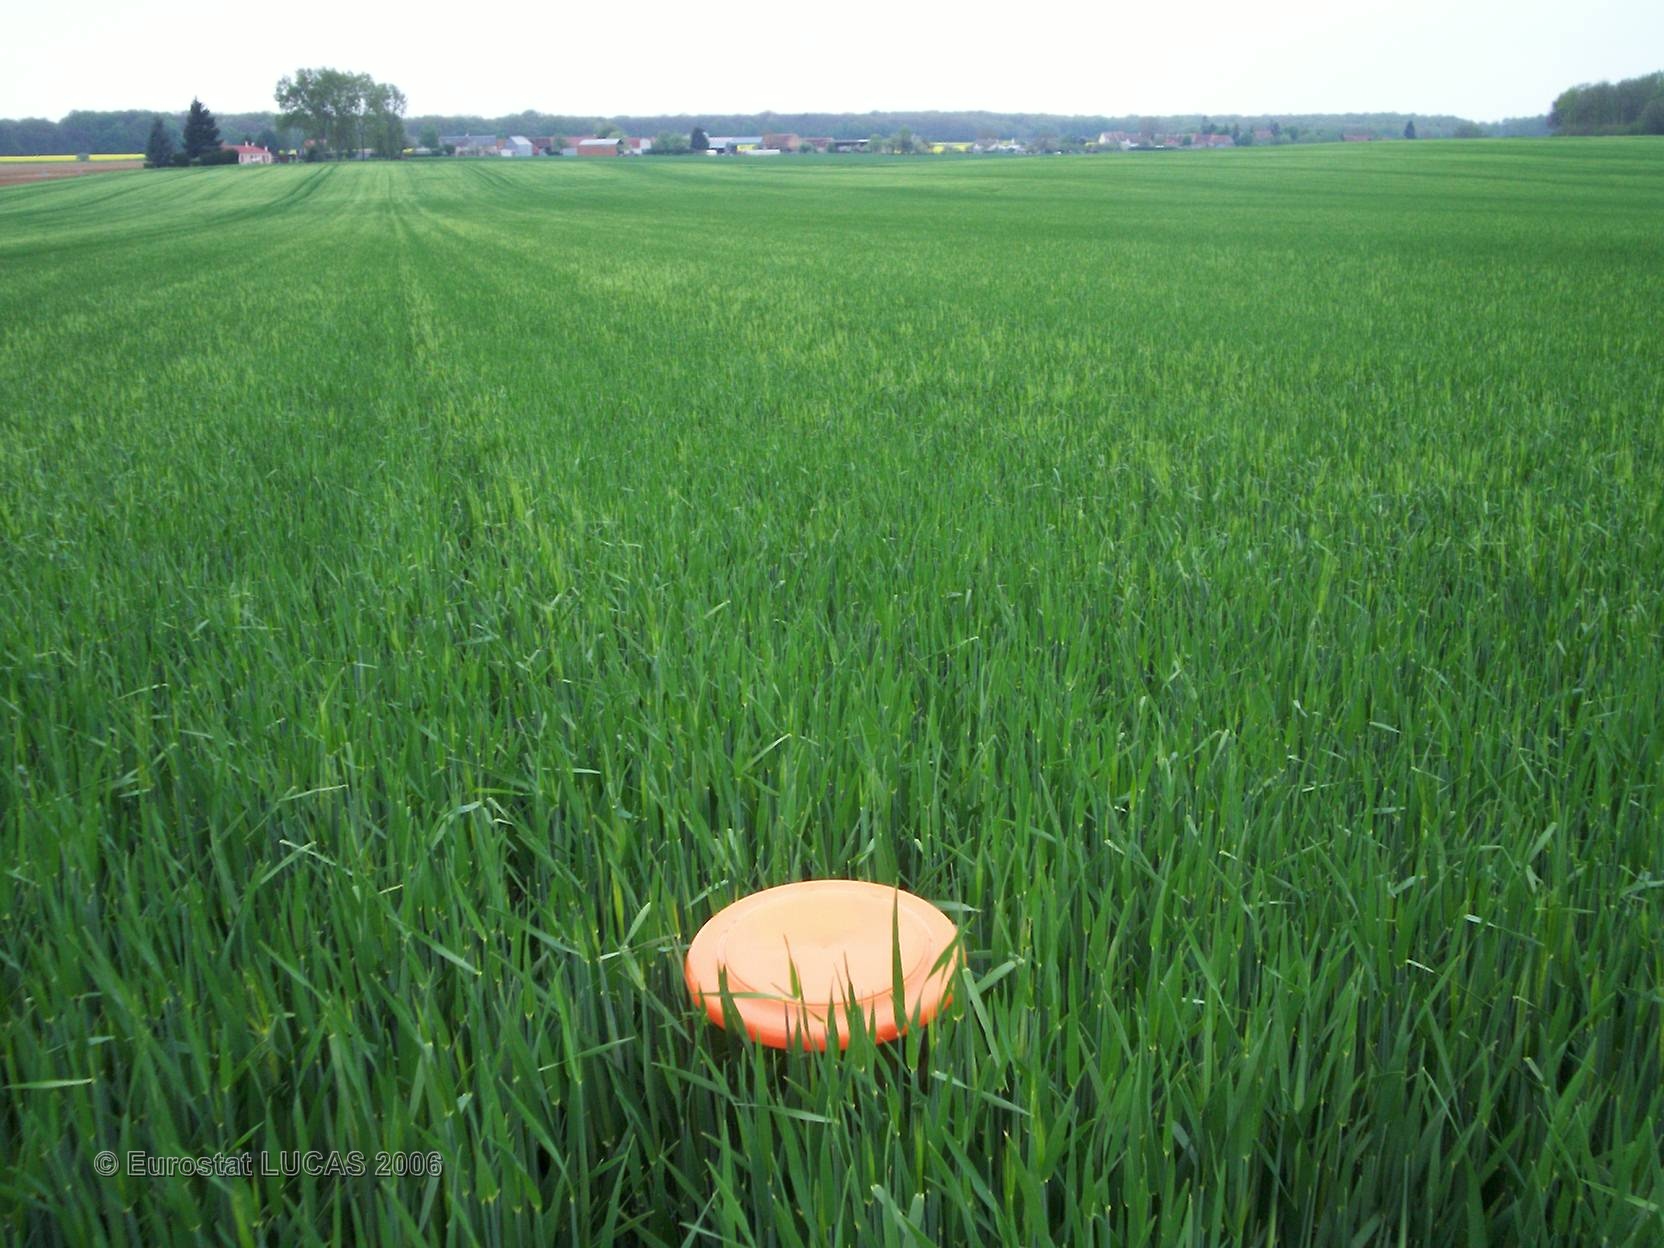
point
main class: Cropland
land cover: Barley
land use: Agriculture (excluding fallow land and kitchen gardens)
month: April
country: FR
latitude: 46.9032
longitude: 1.5475
